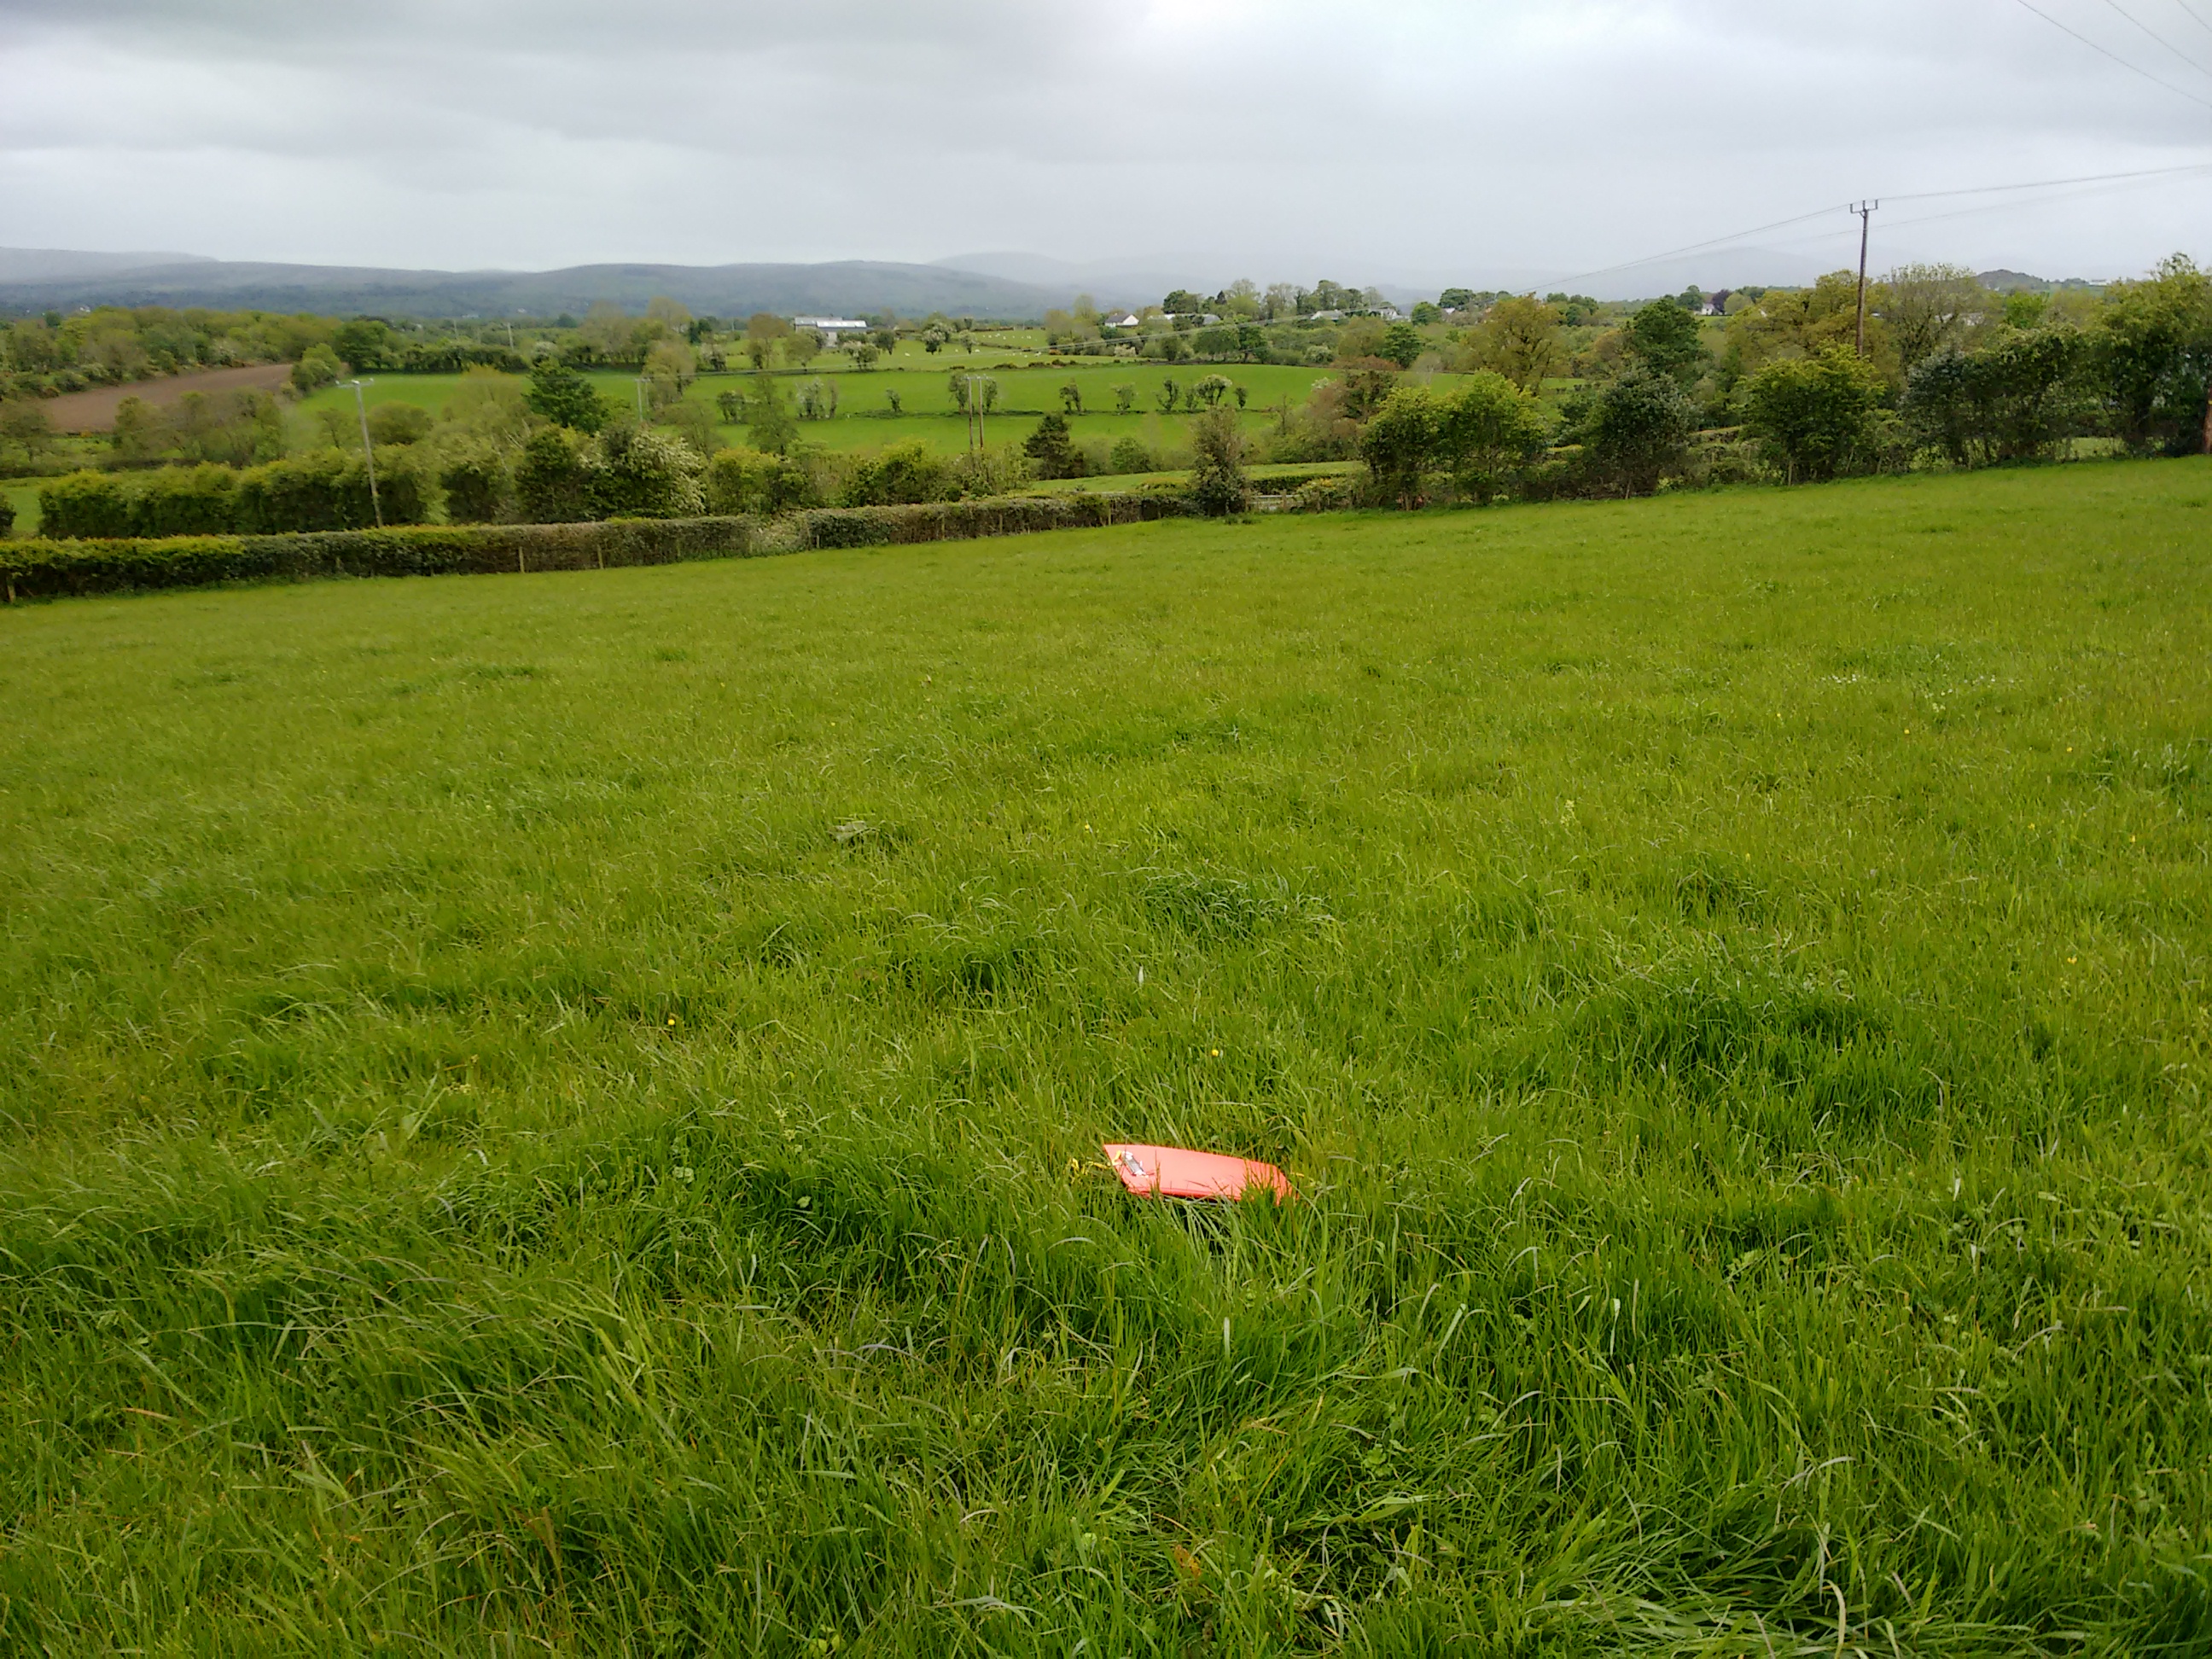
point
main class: Grassland
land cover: Grassland without tree/shrub cover
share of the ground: > 75 %
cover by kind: herbaceous plants 100 %
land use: Agriculture (excluding fallow land and kitchen gardens)
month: June
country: GB
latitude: 54.9546
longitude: -6.9543
